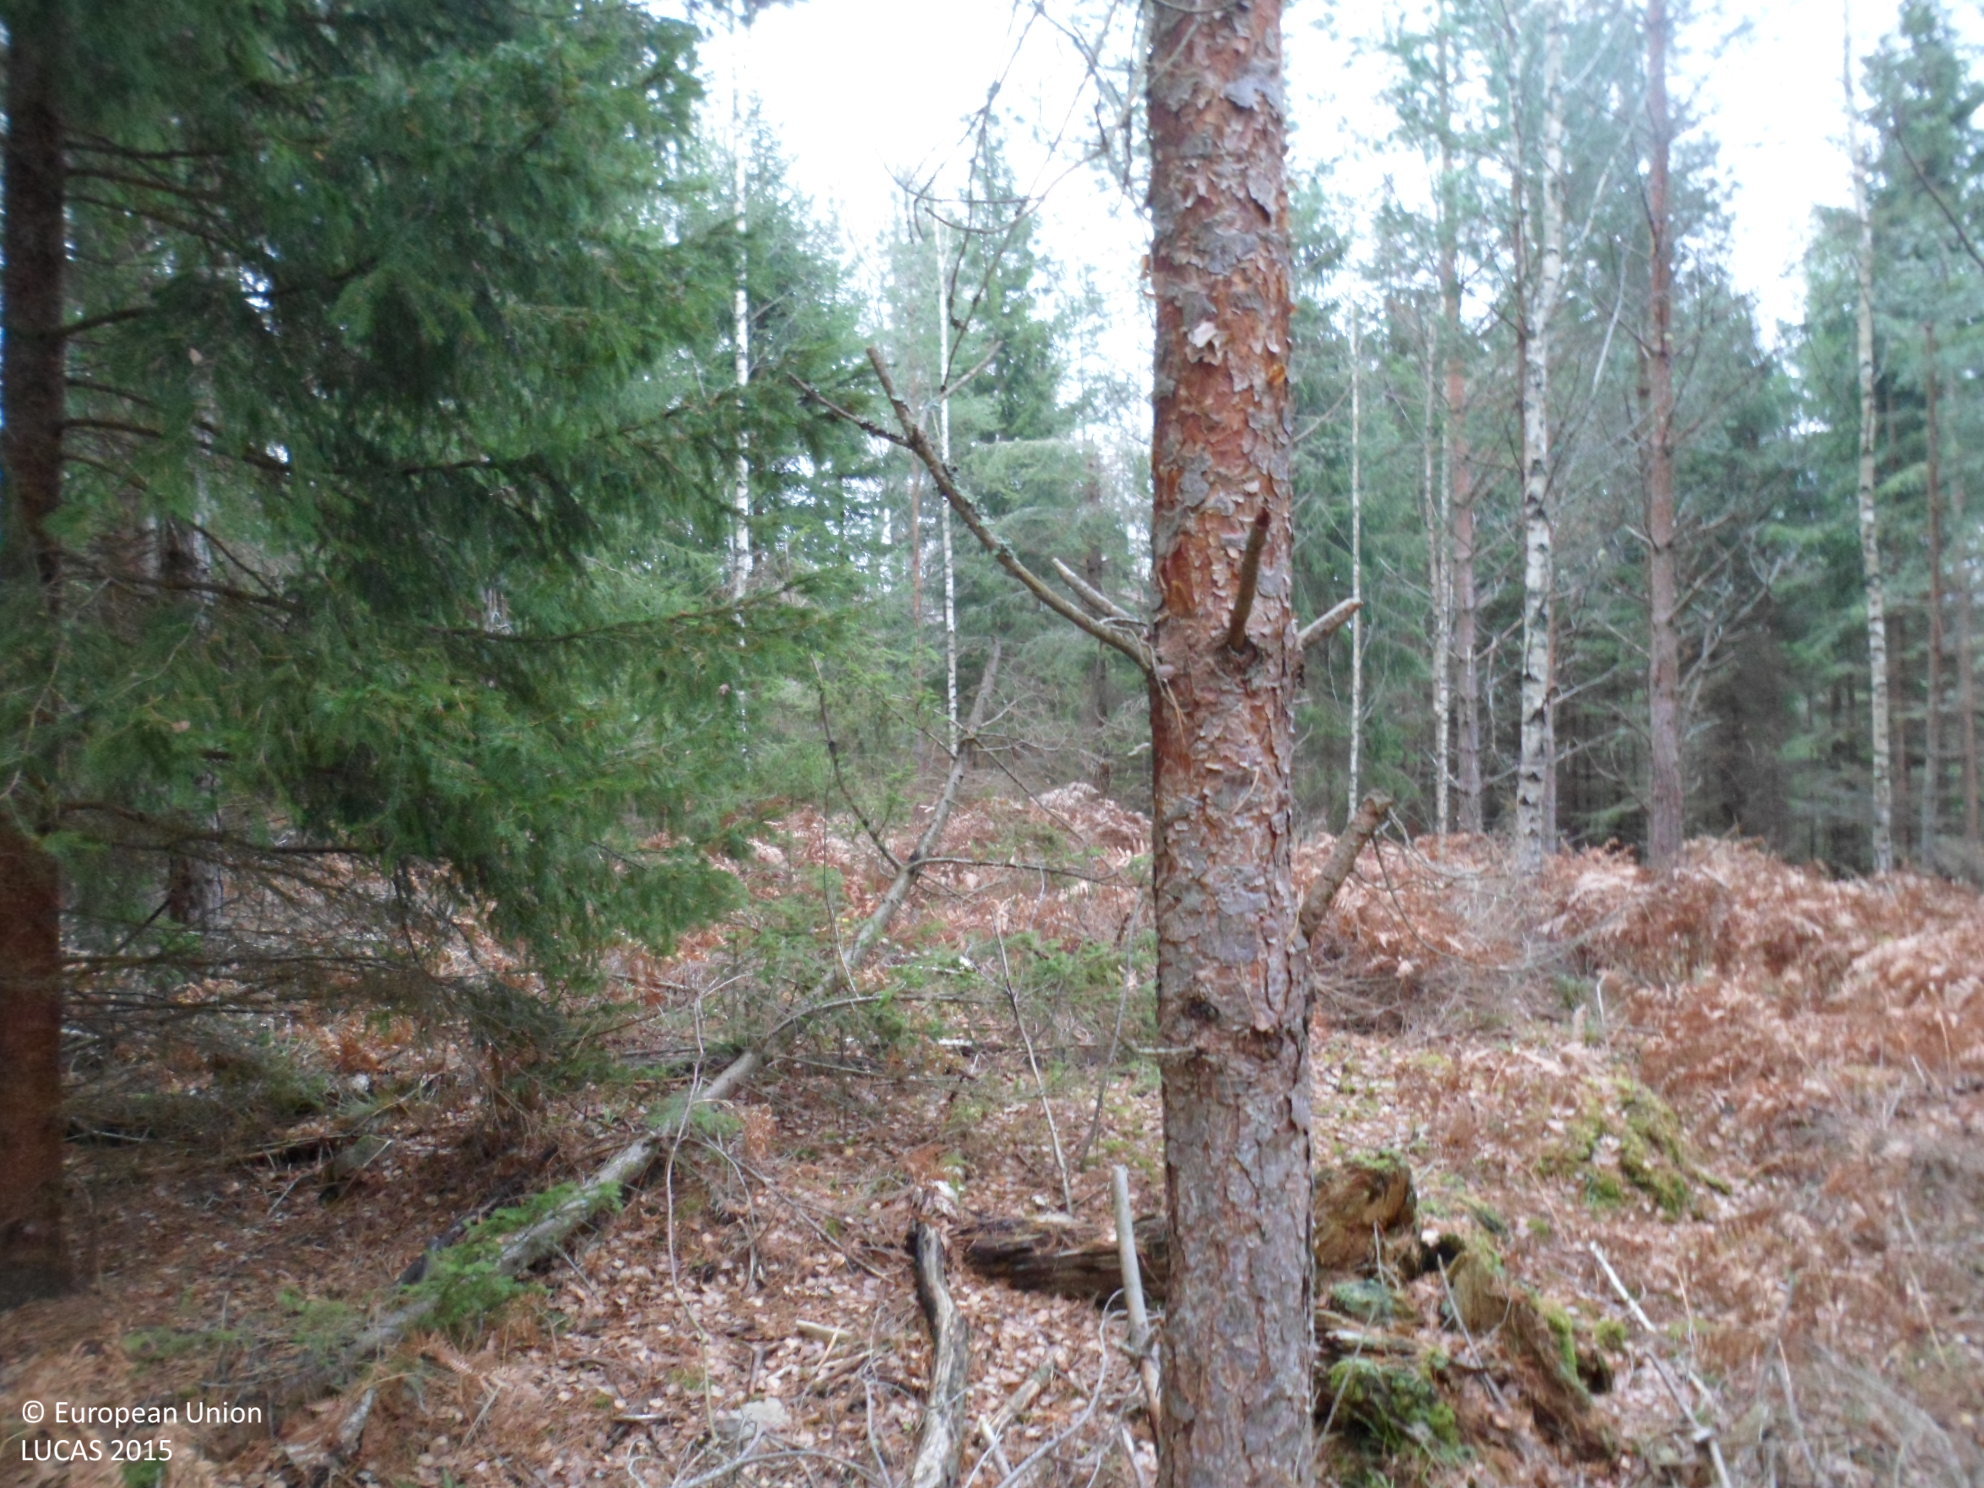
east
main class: Woodland
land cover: Pine dominated coniferous woodland
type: boreal forest
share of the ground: 50 - 75 %
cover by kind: coniferous forest trees 50 %, lichens and mosses 15 %, unconsolidated bare surface 15 %, broadleaved forest trees 10 %, shrubs 10 %
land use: Forestry
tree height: > 5 m
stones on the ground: > 50 %
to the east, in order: Pine dominated coniferous woodland; Spruce dominated mixed woodland; Spruce dominated coniferous woodland
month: November
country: SE
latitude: 57.0489
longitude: 16.1811
